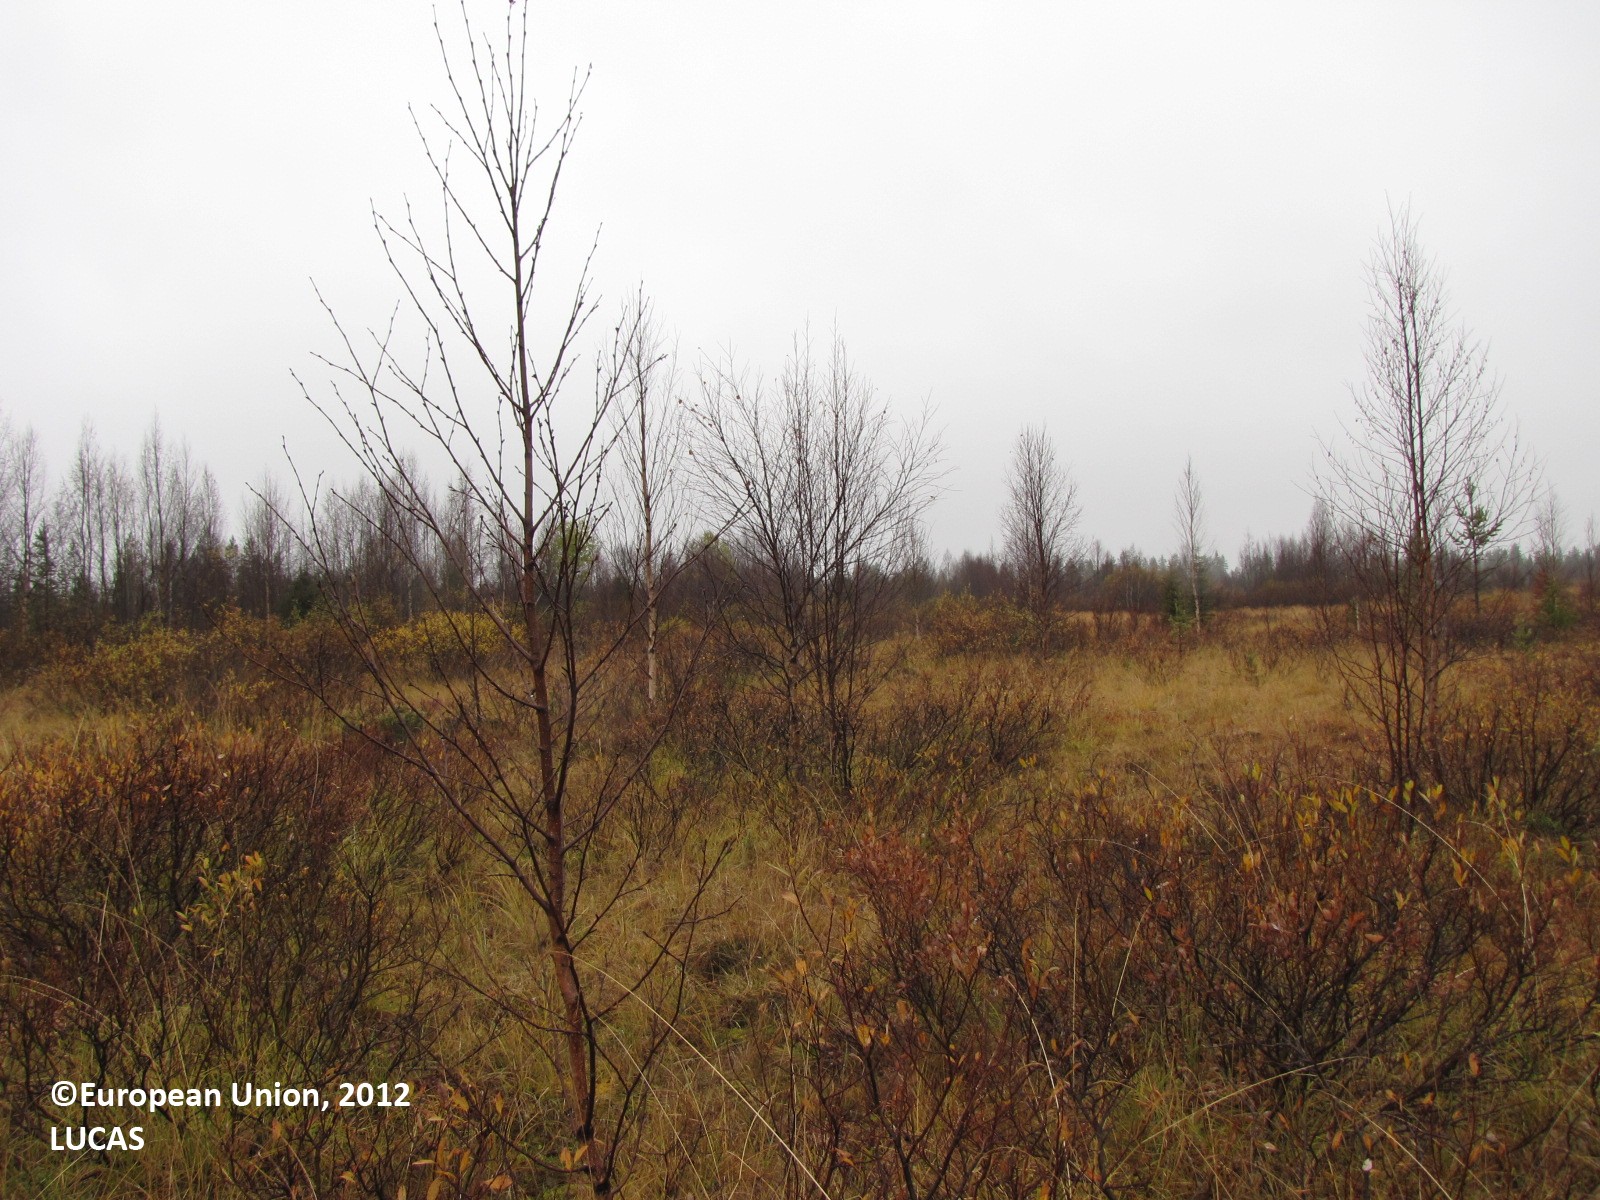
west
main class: Shrubland
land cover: Shrubland with sparse tree cover
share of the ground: 10 - 25 %
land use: Semi-natural and natural areas not in use
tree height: < 5 m
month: September
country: FI
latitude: 67.7501
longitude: 23.6220
